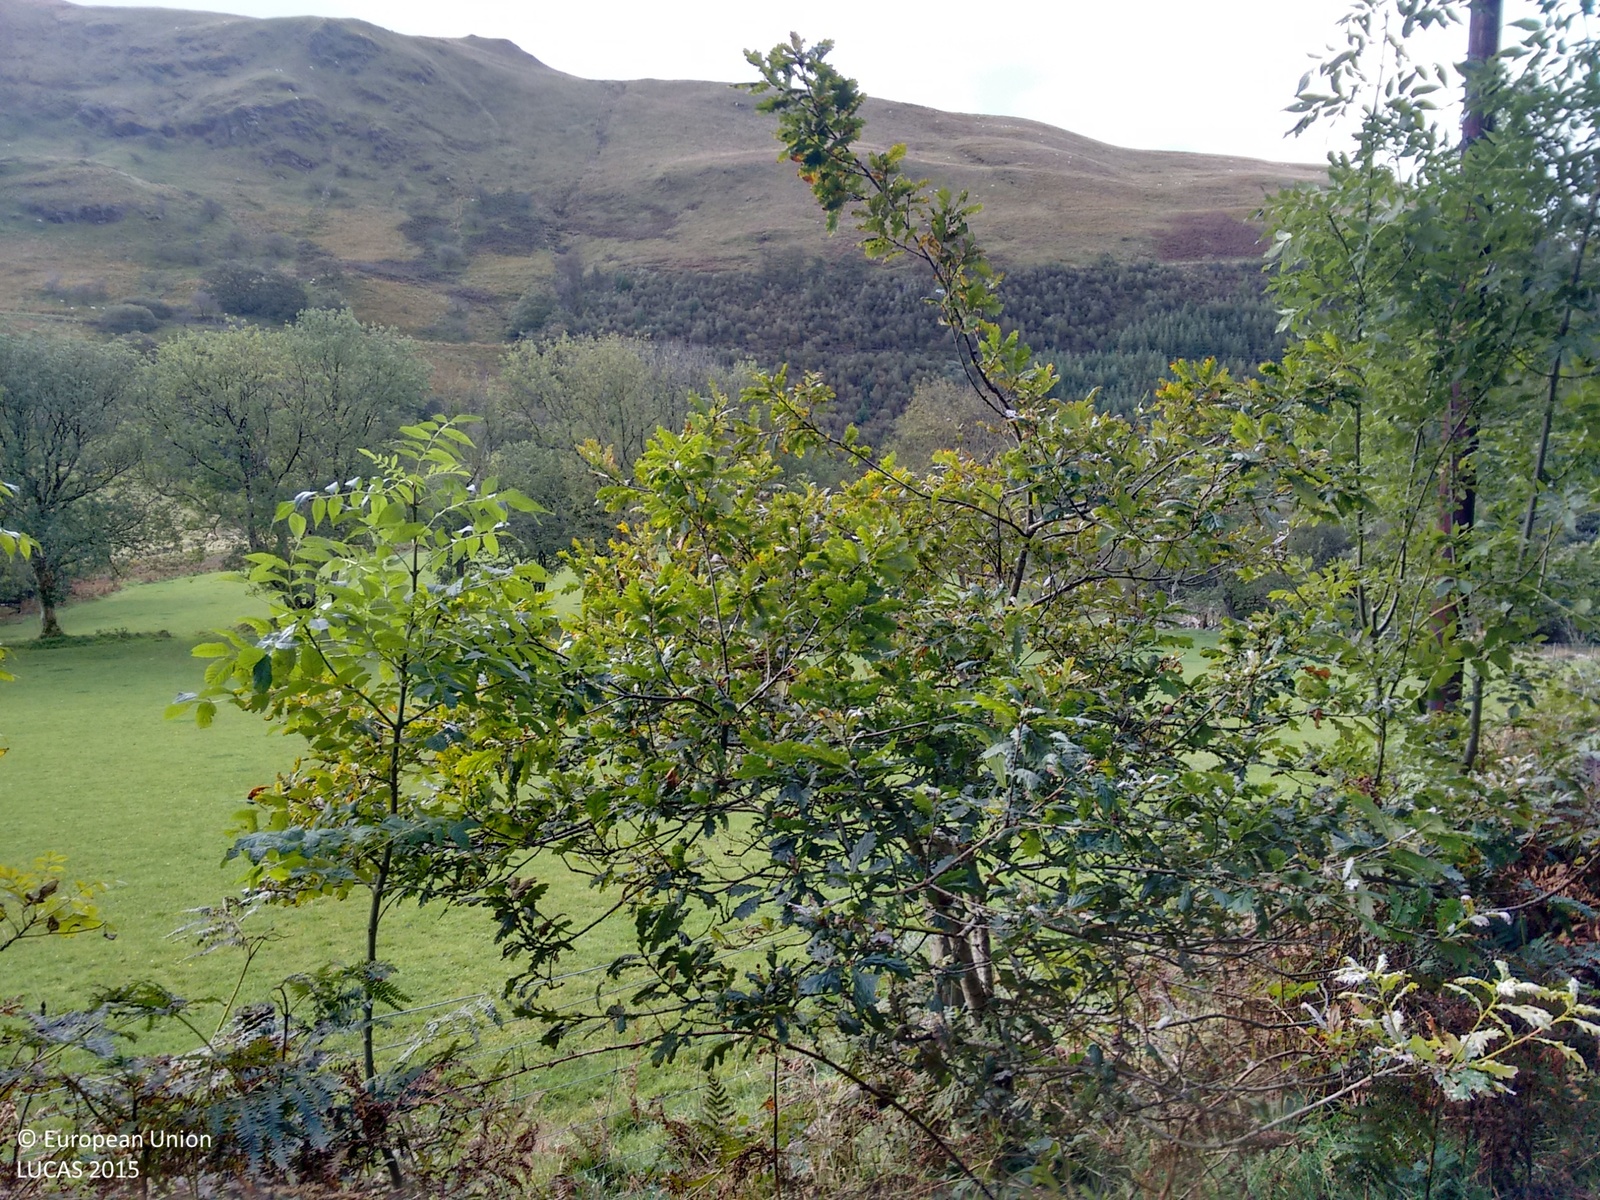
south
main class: Shrubland
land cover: Shrubland without tree cover
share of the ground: > 75 %
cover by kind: shrubs 100 %
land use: Semi-natural and natural areas not in use
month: October
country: GB
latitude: 52.4689
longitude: -3.8851
